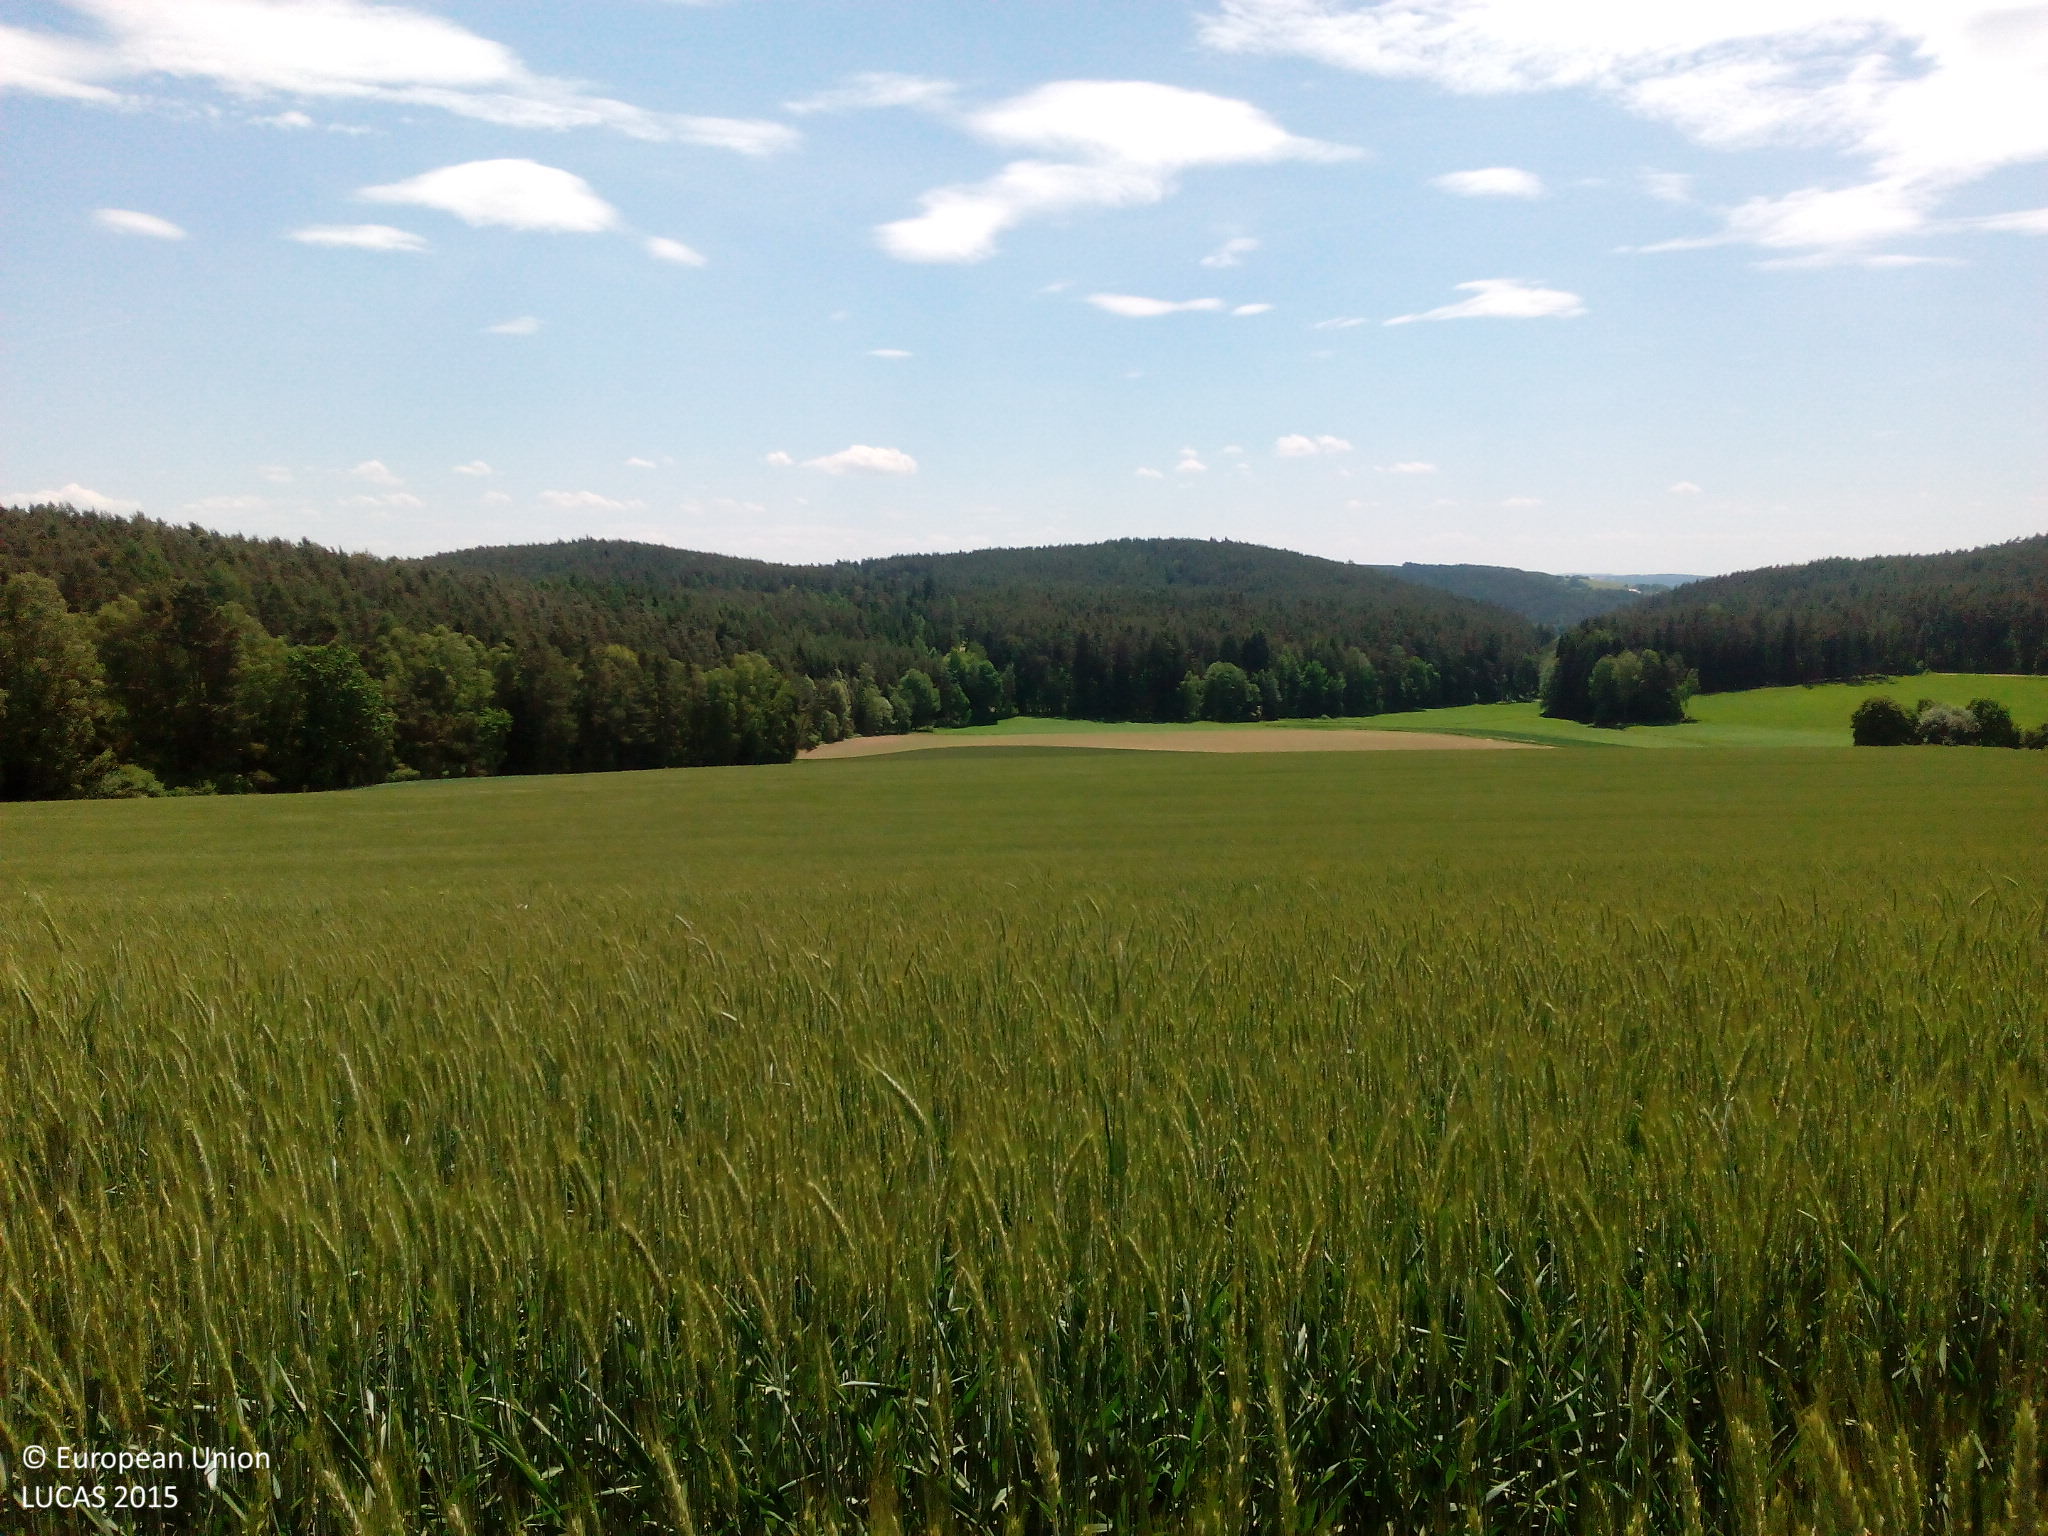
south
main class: Cropland
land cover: Common wheat
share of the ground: > 75 %
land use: Agriculture (excluding fallow land and kitchen gardens)
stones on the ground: 10 - 25 %
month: June
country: DE
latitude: 49.4250
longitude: 12.2192
